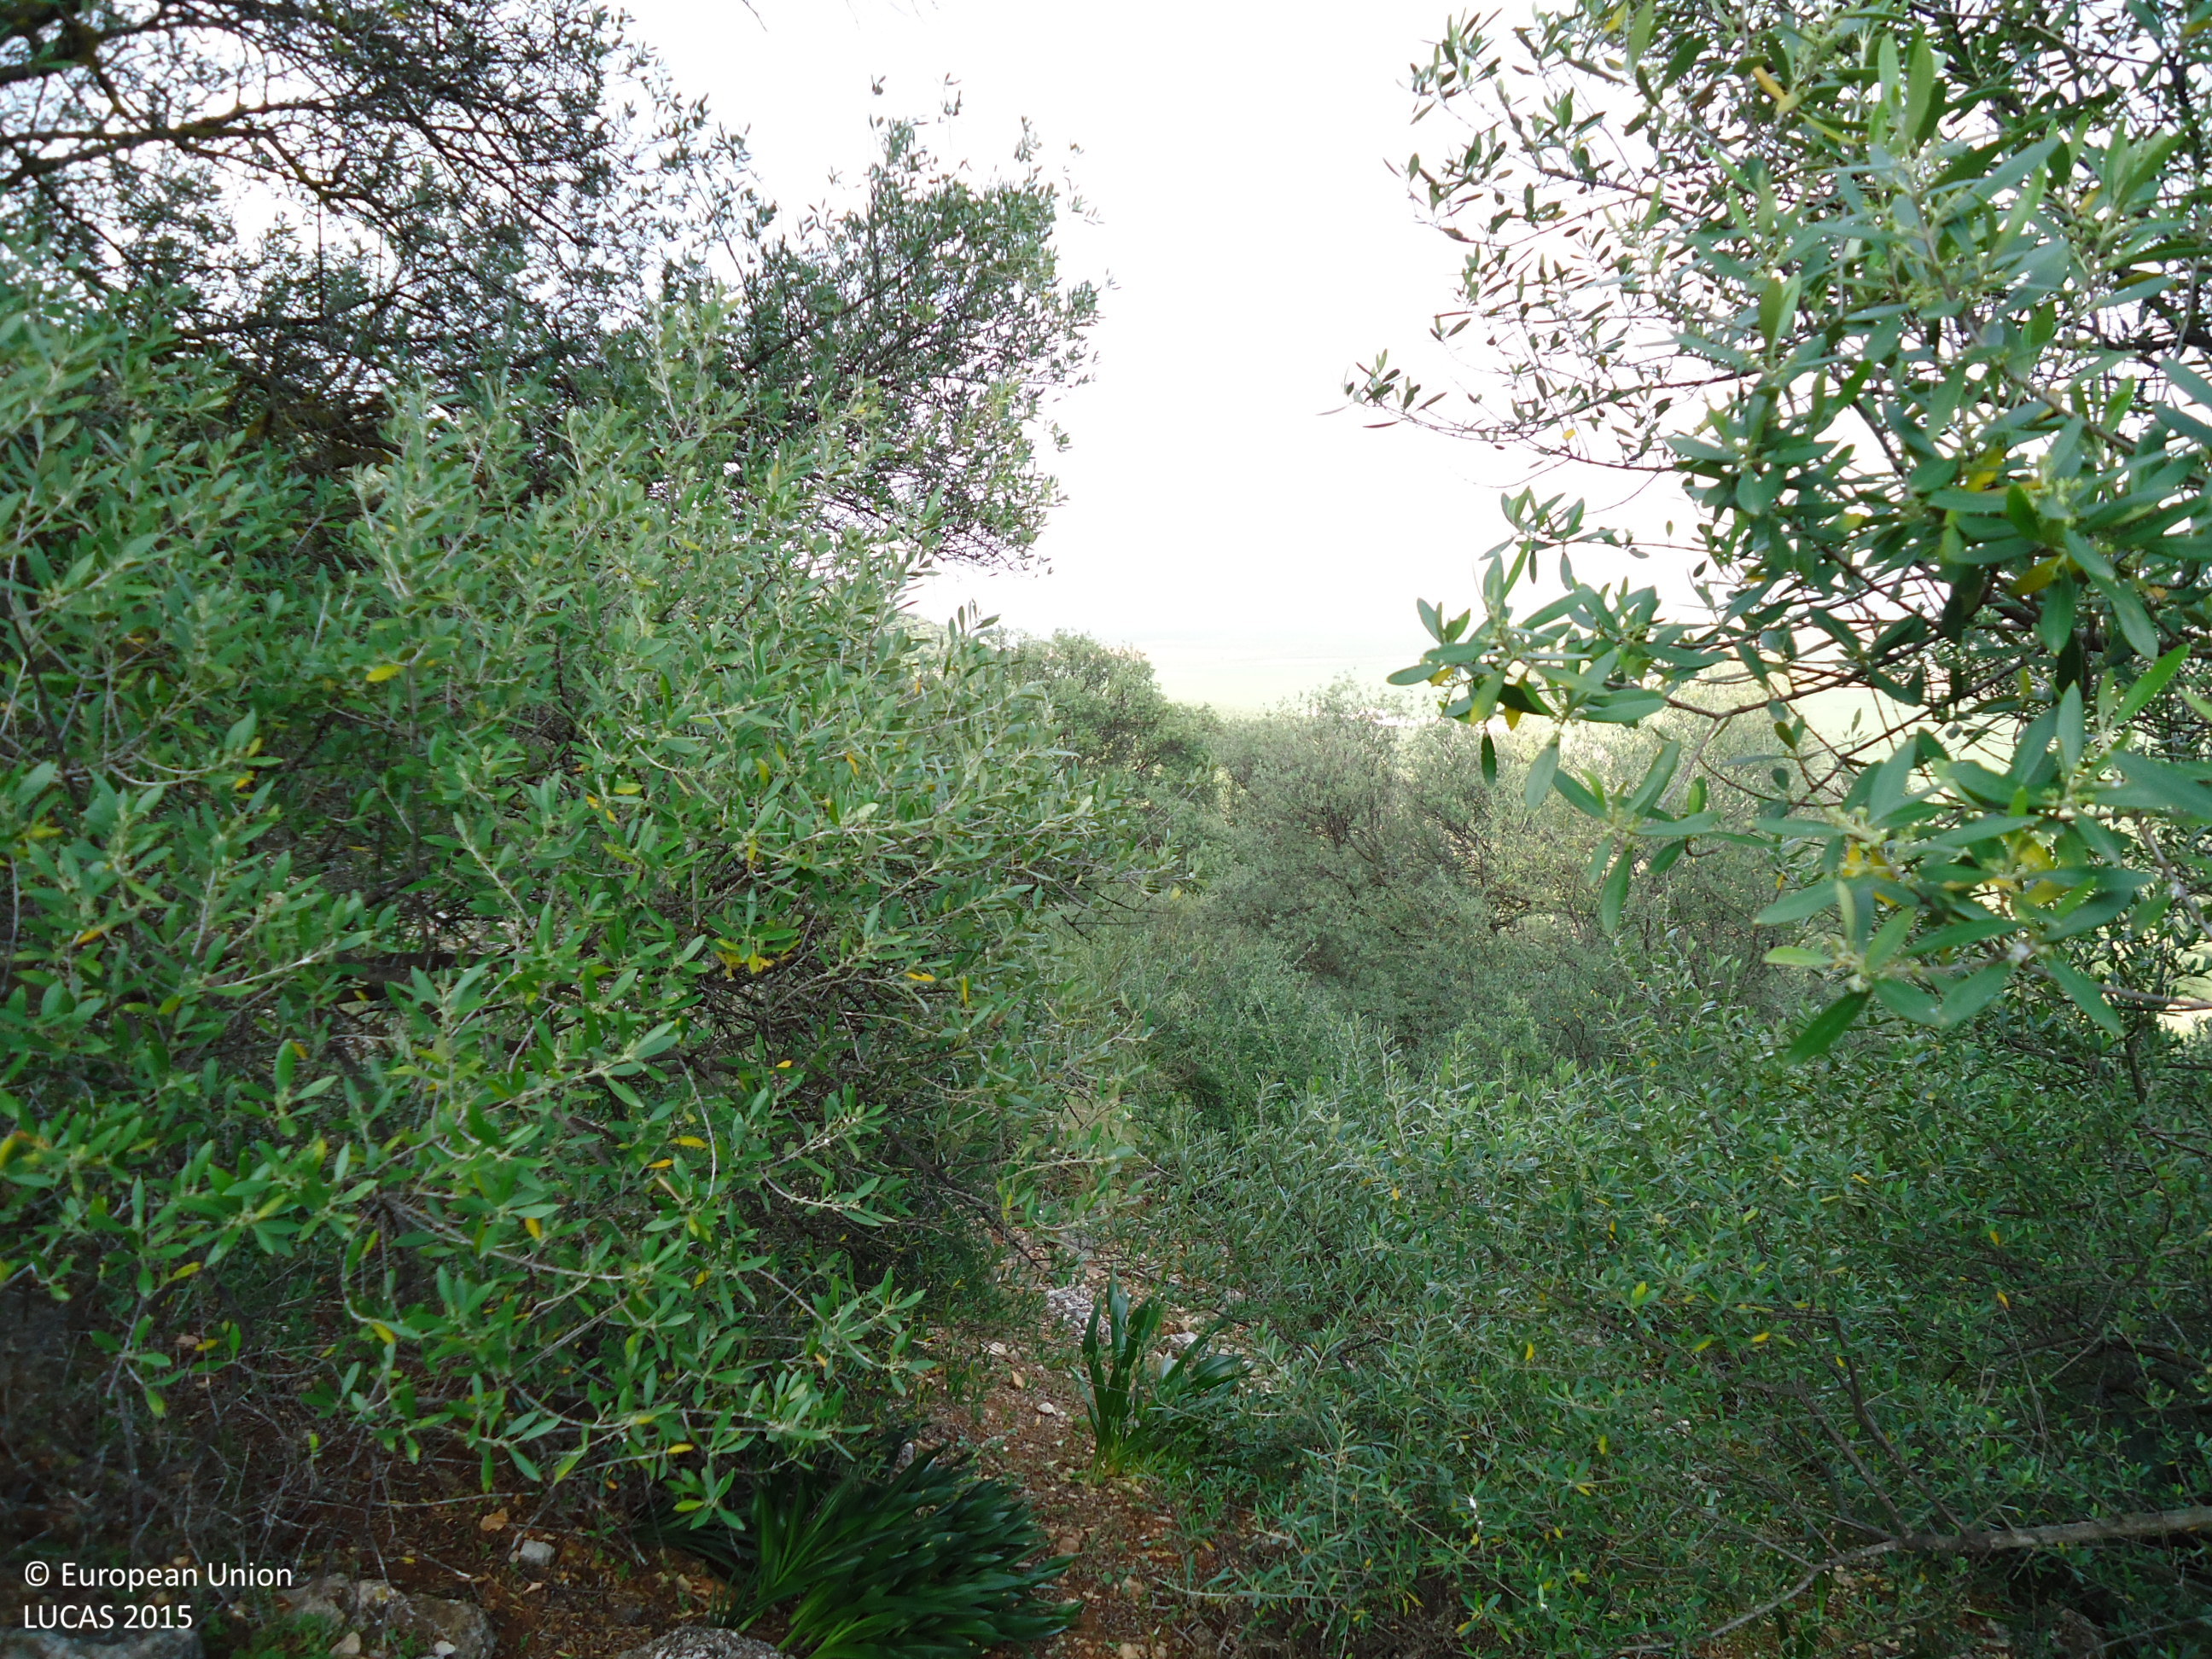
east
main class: Shrubland
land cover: Shrubland with sparse tree cover
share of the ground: 25 - 50 %
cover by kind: herbaceous plants 60 %, shrubs 35 %, broadleaved forest trees 5 %
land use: Semi-natural and natural areas not in use
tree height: < 5 m
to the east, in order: Shrubland with sparse tree cover; Rock outcrops; Shrubland with sparse tree cover; Rock outcrops; Shrubland with sparse tree cover; Grassland with sparse tree/shrub cover; Rock outcrops; Shrubland with sparse tree cover
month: April
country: ES
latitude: 37.1659
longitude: -4.8341
